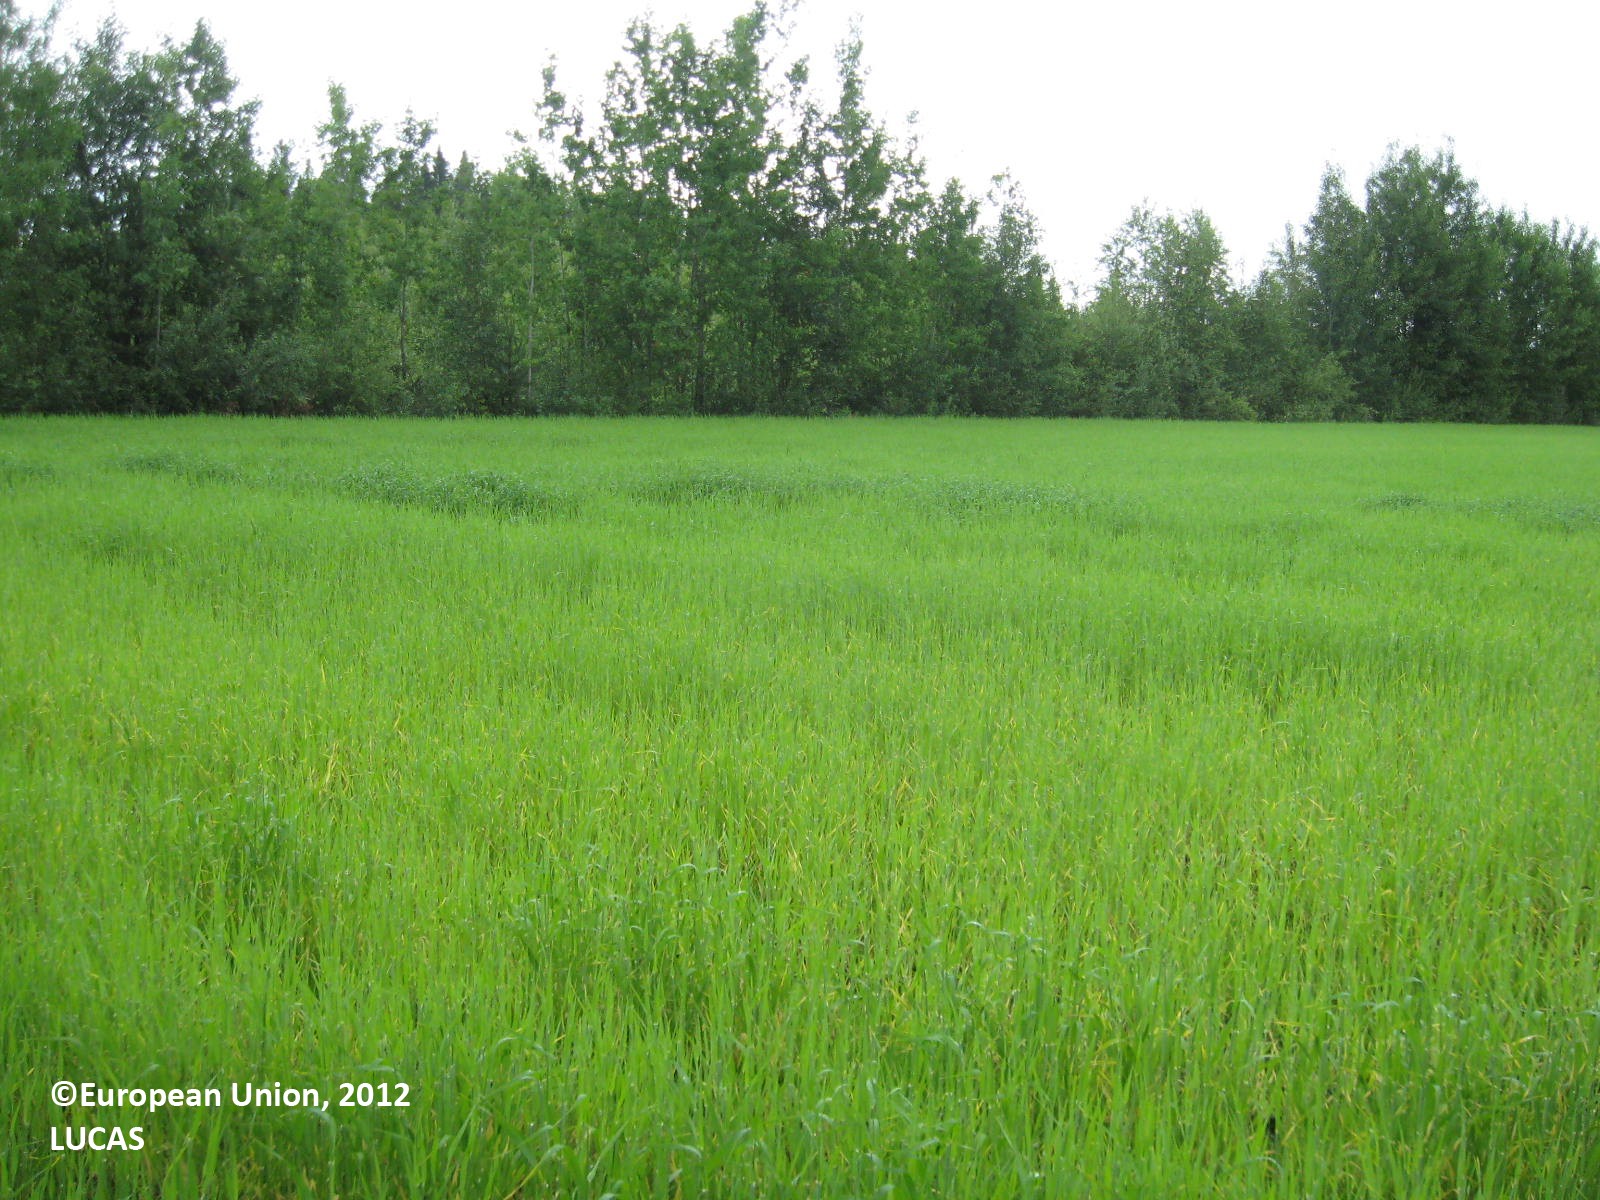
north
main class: Cropland
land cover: Barley
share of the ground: > 75 %
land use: Agriculture (excluding fallow land and kitchen gardens)
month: July
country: FI
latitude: 62.3536
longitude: 22.8309
